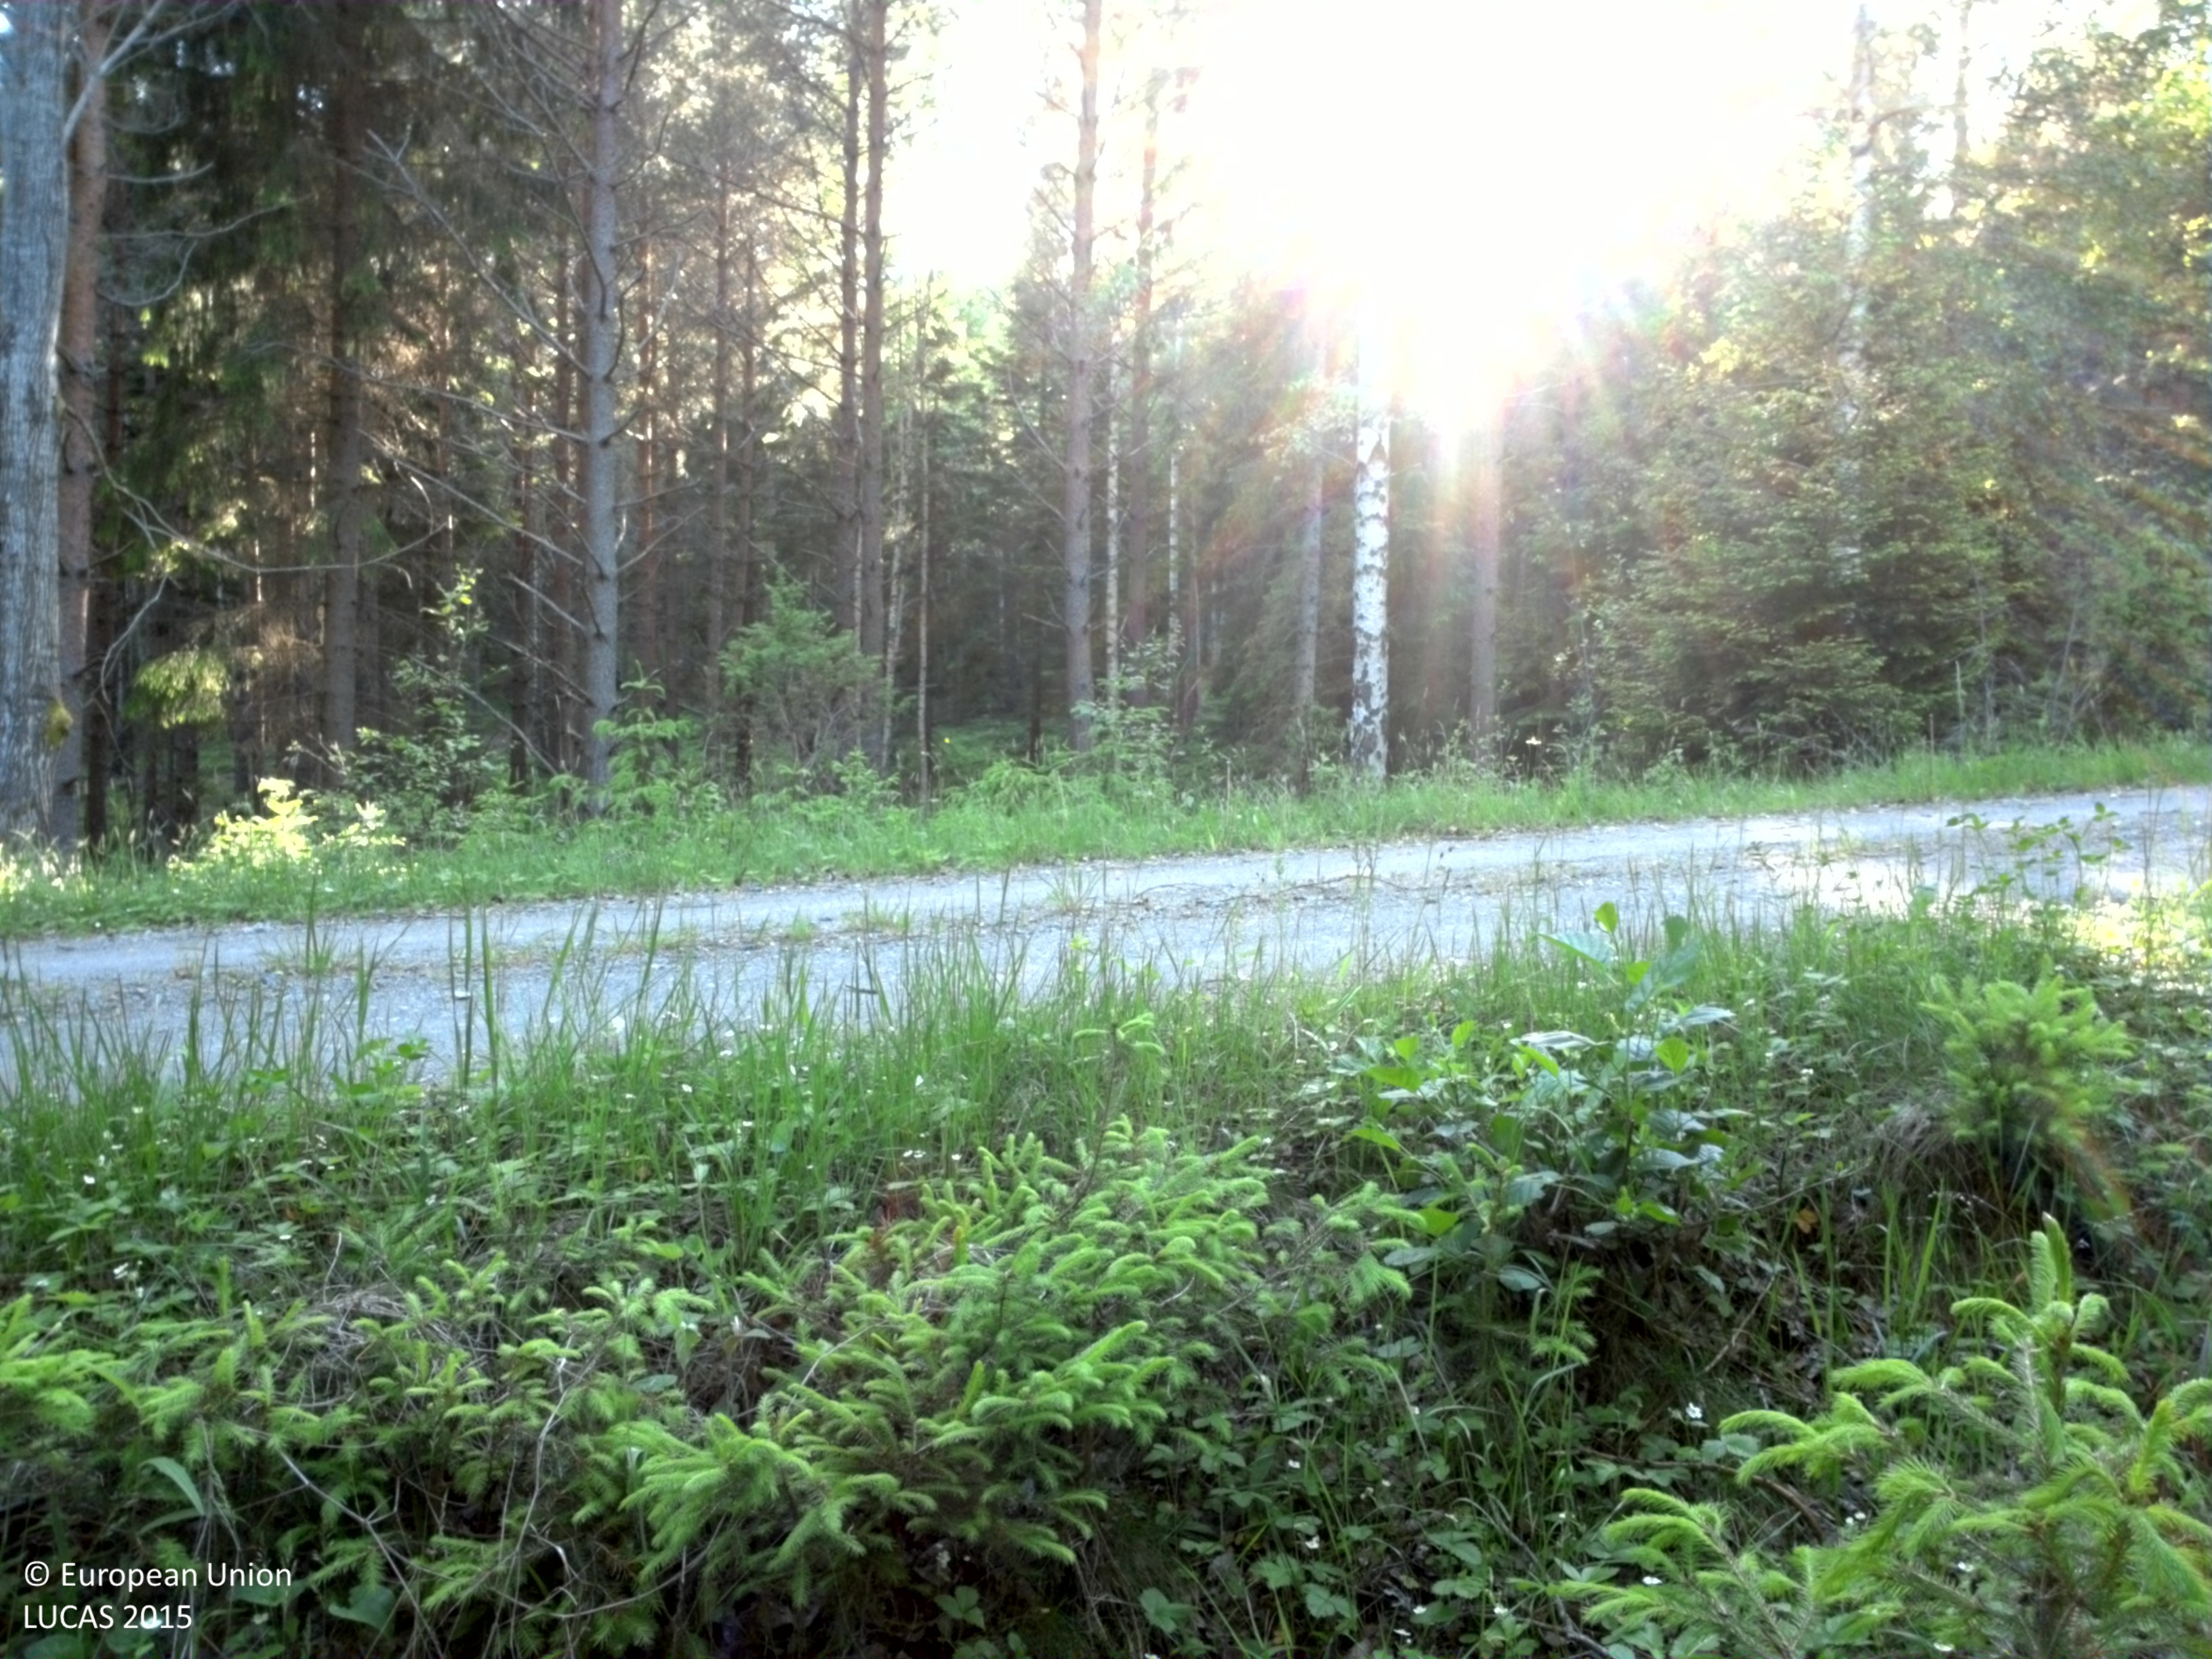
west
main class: Woodland
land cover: Spruce dominated mixed woodland
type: boreal forest
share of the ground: 50 - 75 %
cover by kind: coniferous forest trees 50 %, broadleaved forest trees 25 %, herbaceous plants 20 %, shrubs 5 %
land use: Forestry
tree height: > 5 m
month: June
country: SE
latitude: 58.6636
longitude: 14.5960
